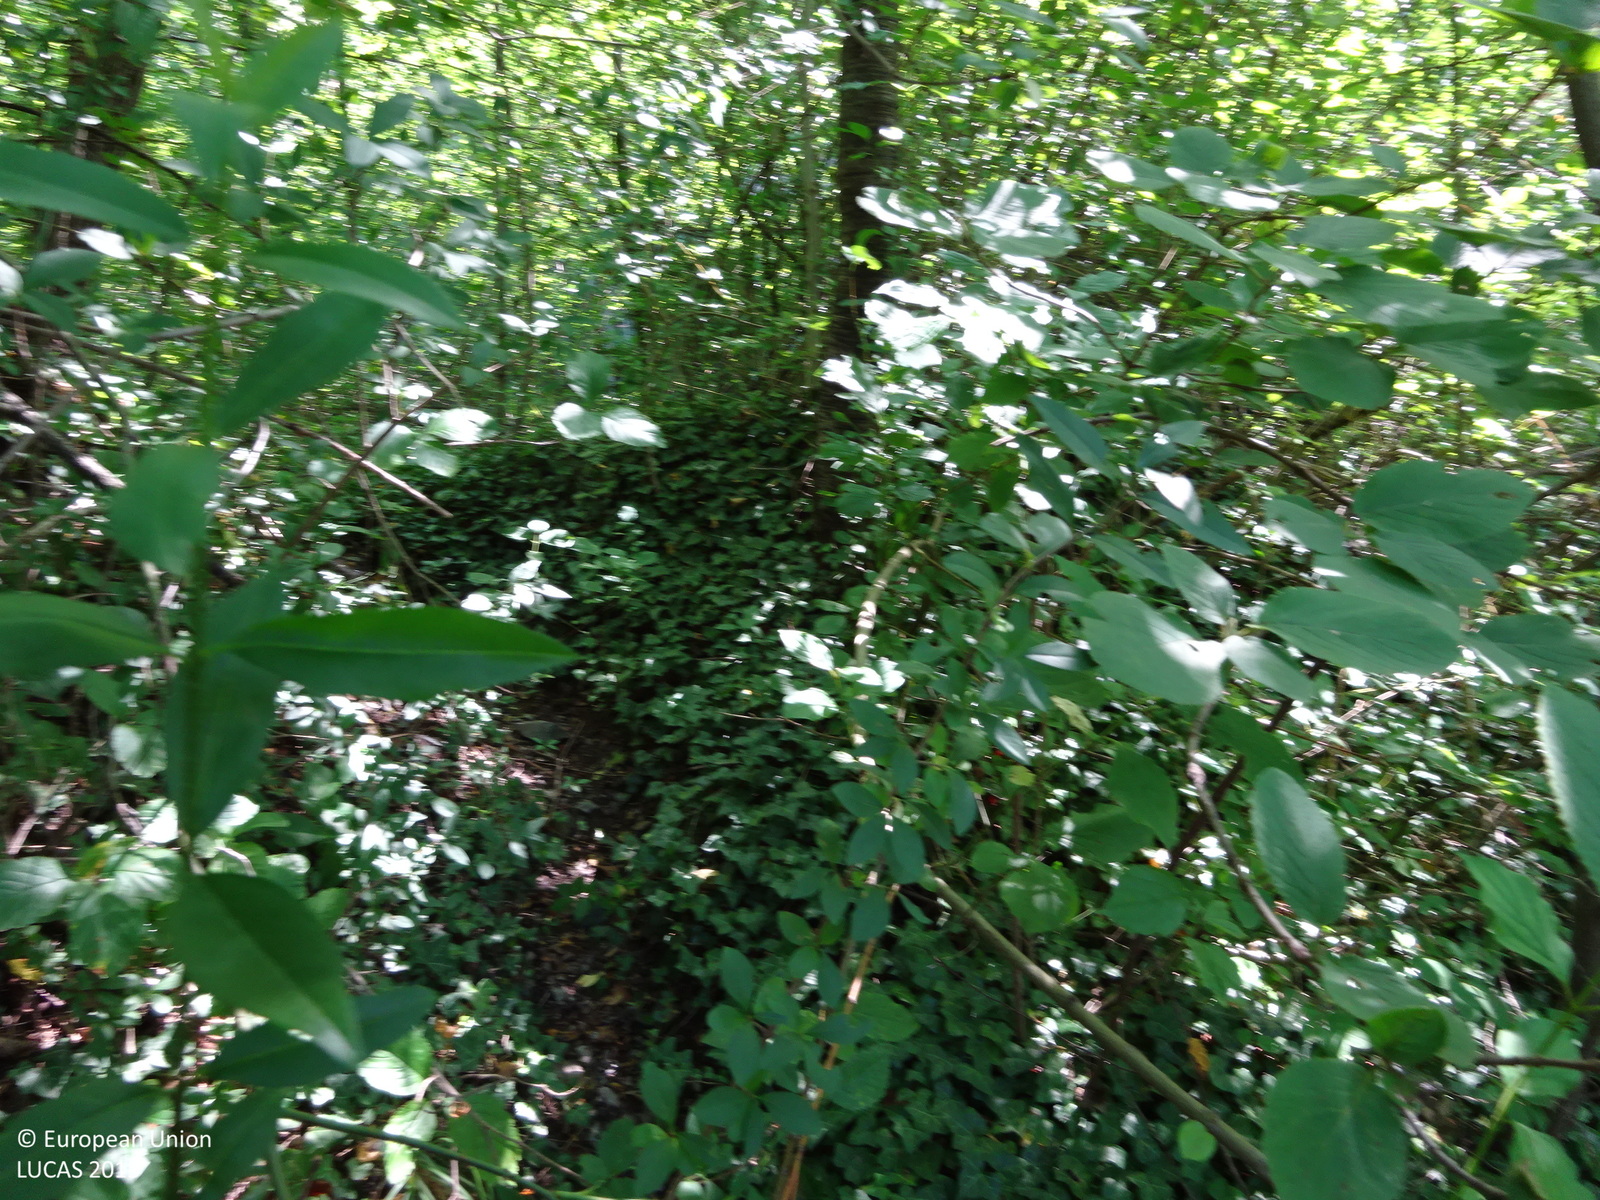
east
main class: Woodland
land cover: Broadleaved woodland
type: hemiboreal forest and nemoral coniferous forest and mixed broadleaved-coniferous forest
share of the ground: > 75 %
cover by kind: broadleaved forest trees 90 %, shrubs 10 %
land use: Forestry
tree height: > 5 m
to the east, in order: Broadleaved woodland; Fences; Broadleaved woodland; Rocks and stones; Broadleaved woodland; Rocks and stones; Broadleaved woodland
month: July
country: AT
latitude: 47.2100
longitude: 15.3471
